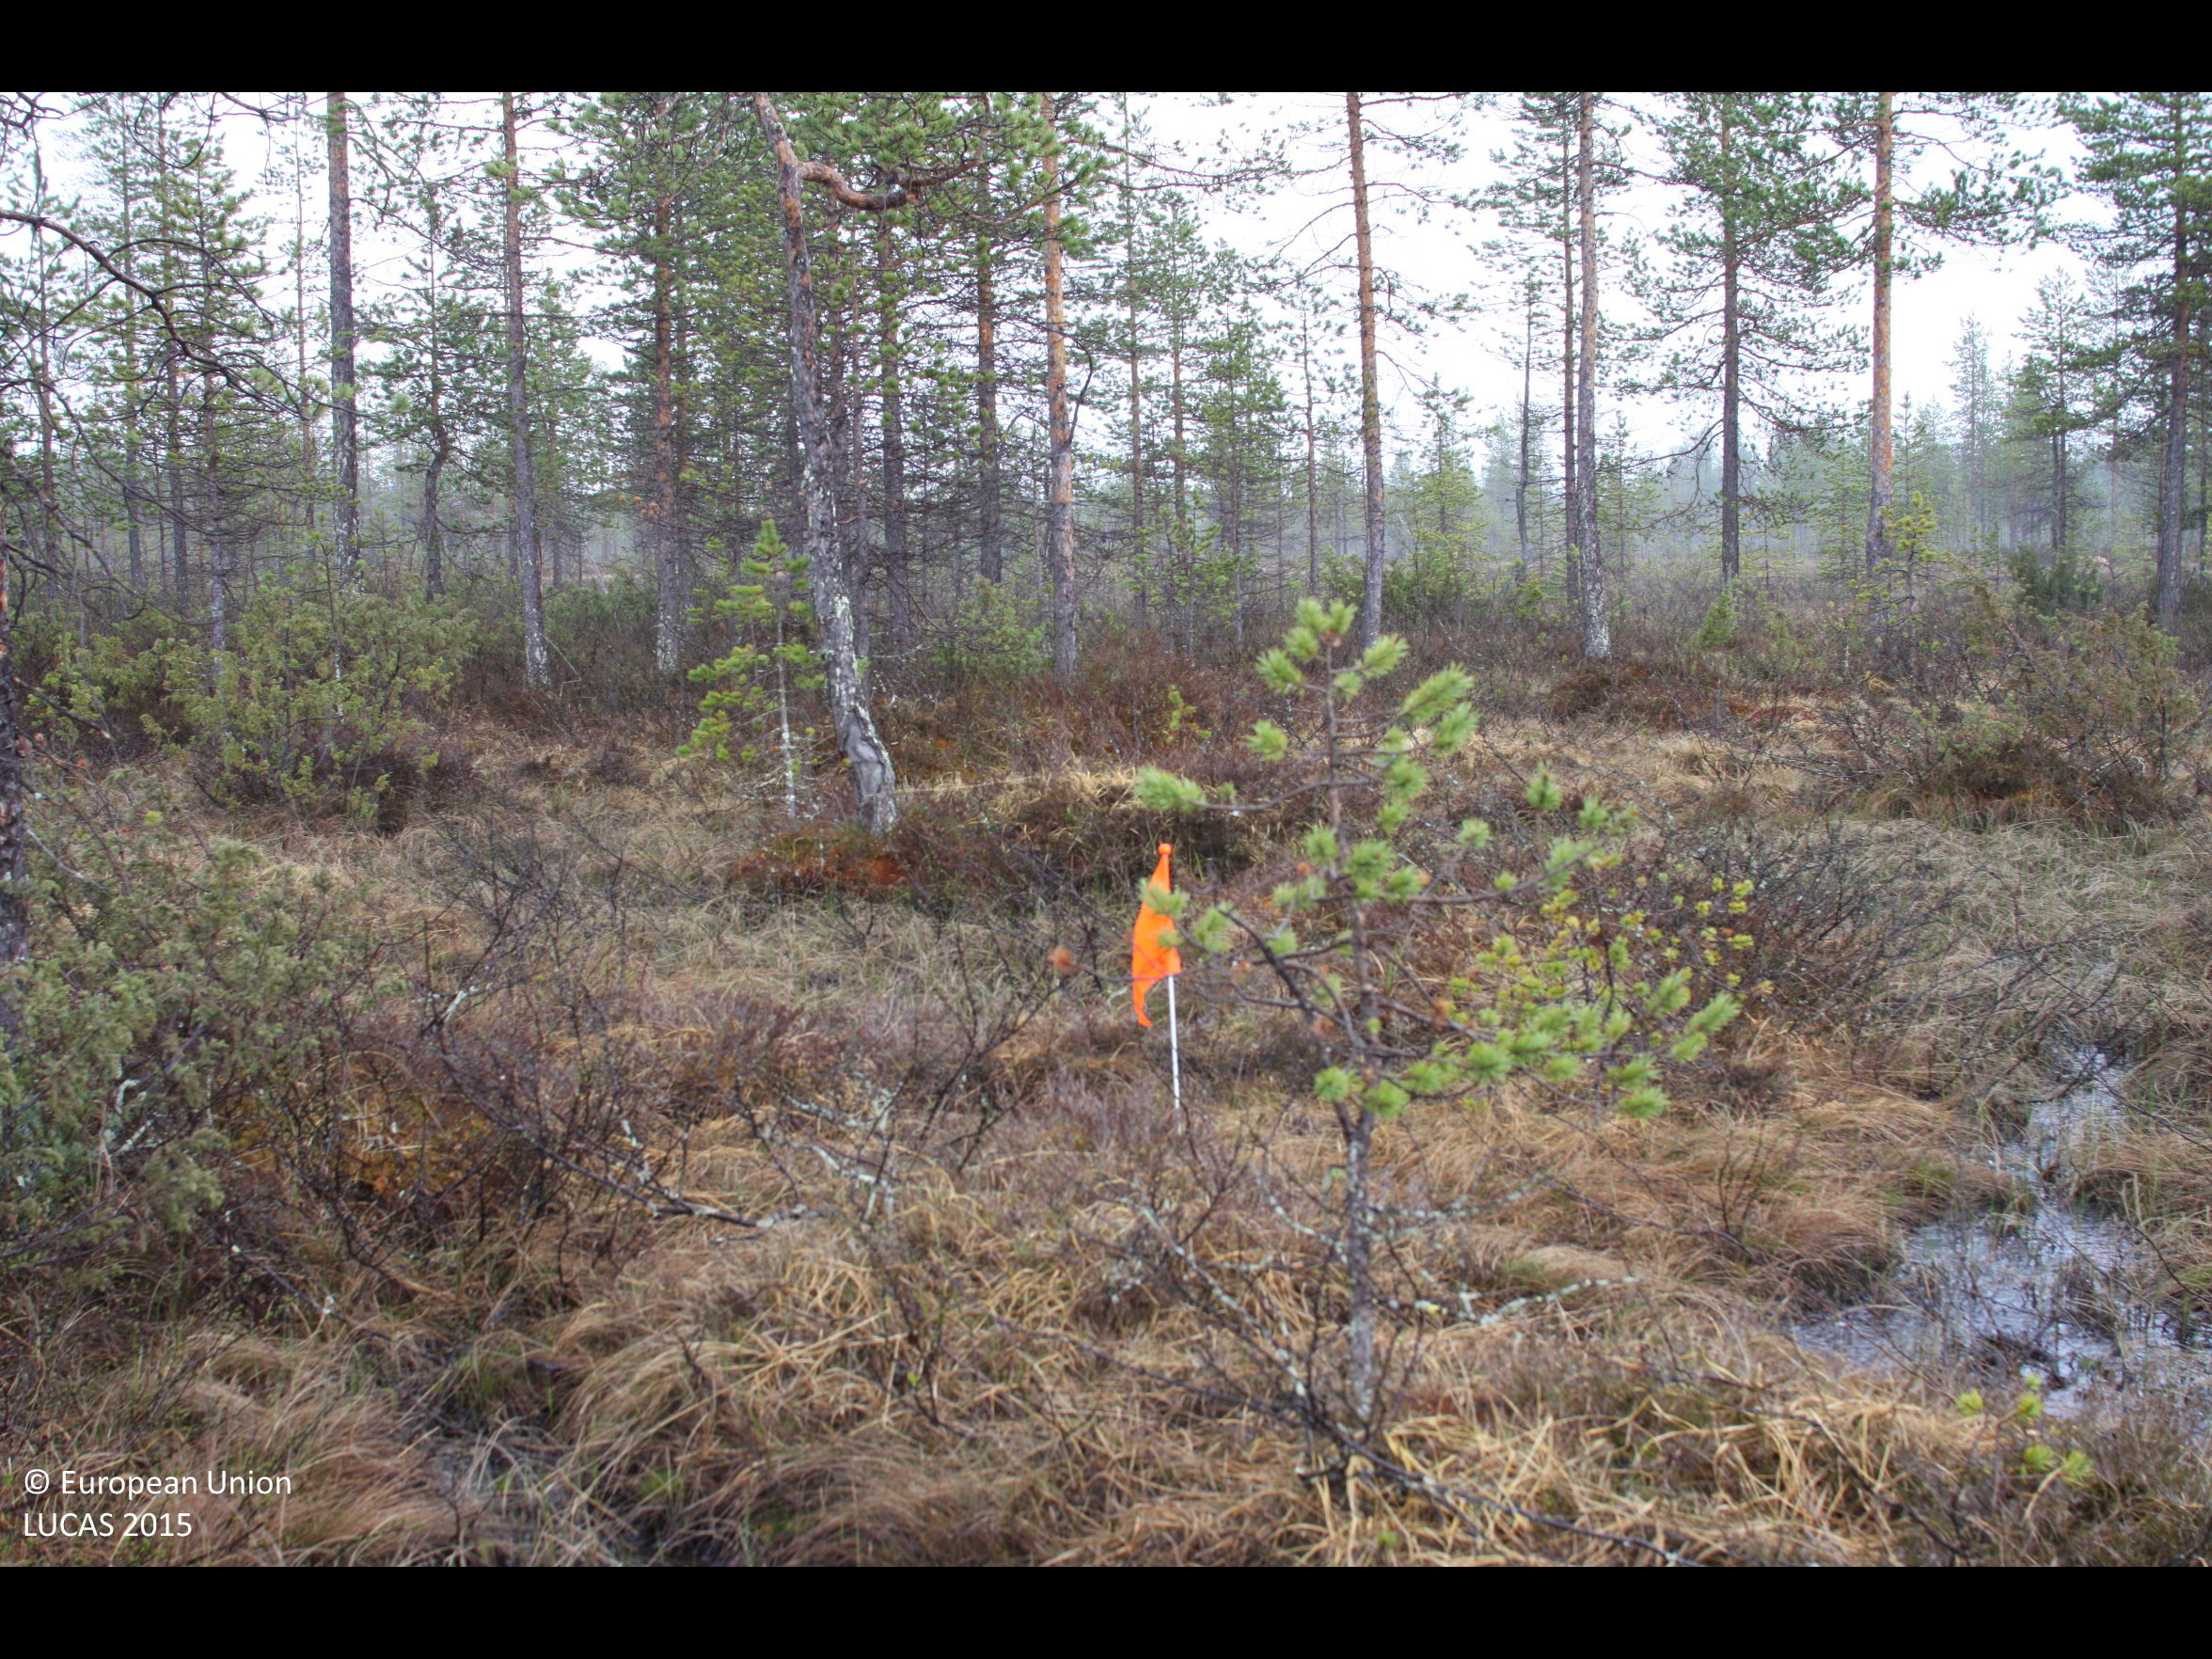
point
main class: Woodland
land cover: Pine dominated coniferous woodland
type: mire and swamp forests
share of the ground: 25 - 50 %
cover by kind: herbaceous plants 30 %, coniferous forest trees 25 %, lichens and mosses 25 %, shrubs 20 %
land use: Forestry
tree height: > 5 m
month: June
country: FI
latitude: 66.2768
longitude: 28.2506
